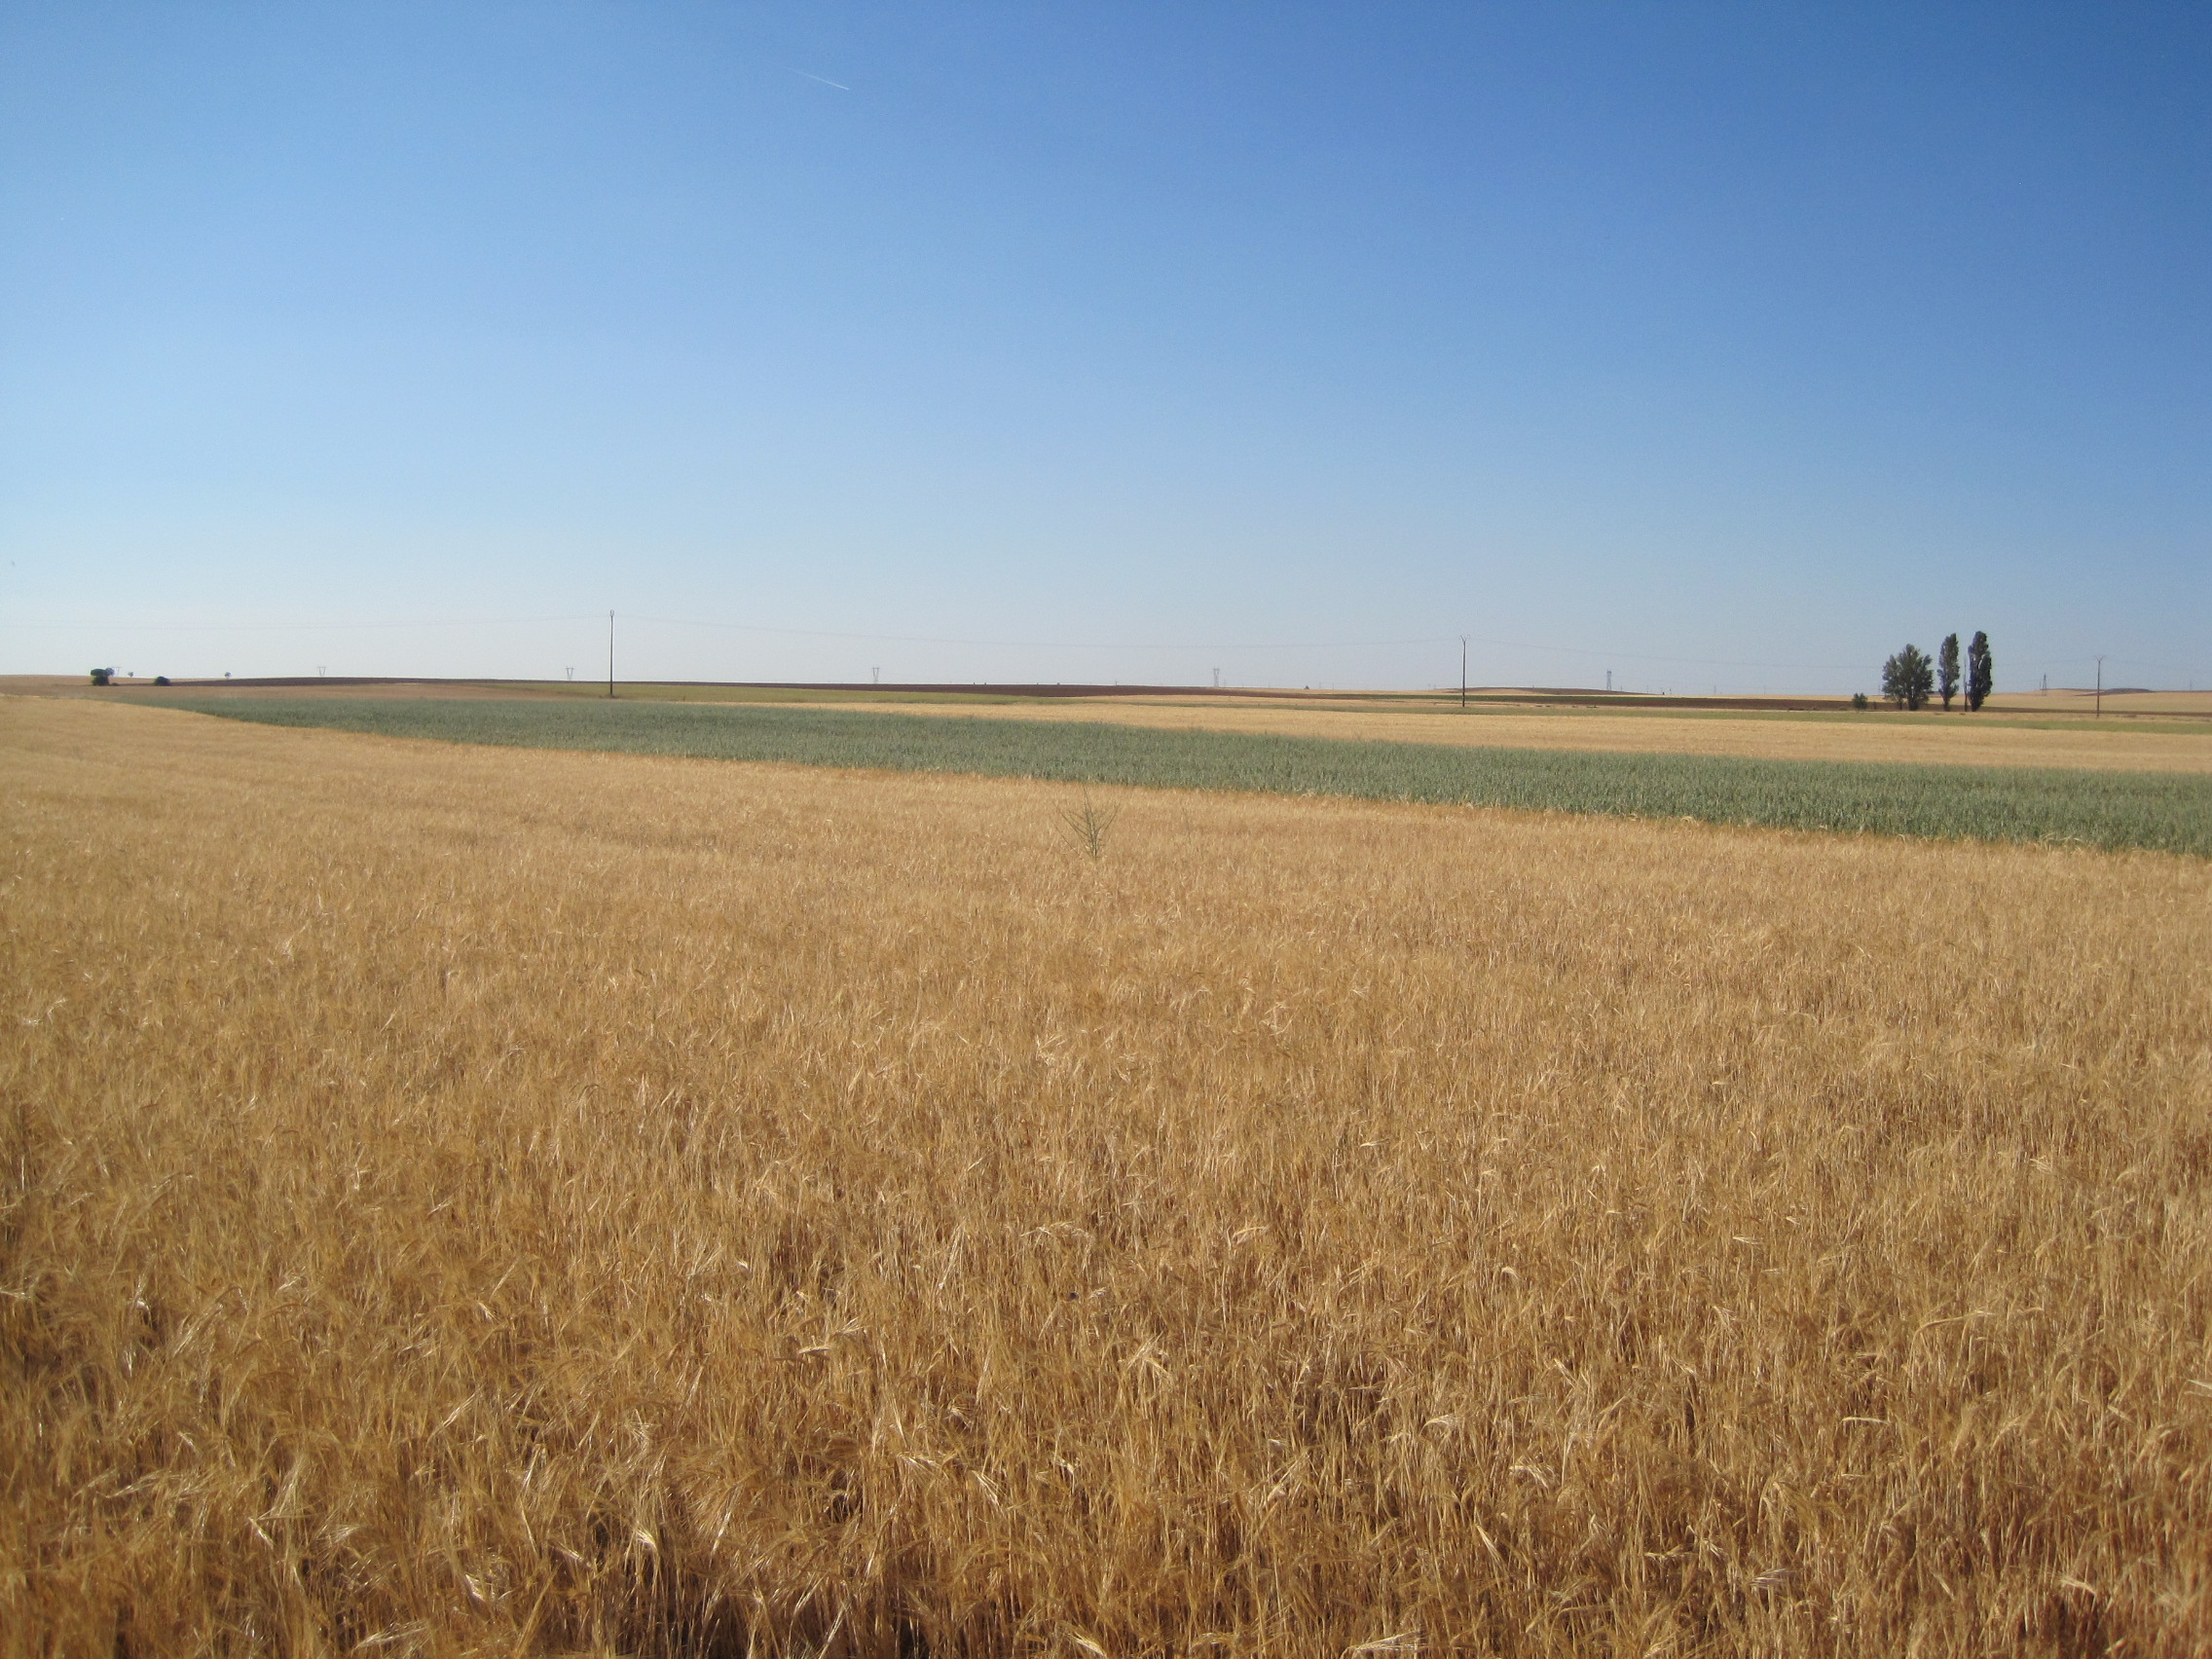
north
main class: Cropland
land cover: Barley
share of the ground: > 75 %
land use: Agriculture (excluding fallow land and kitchen gardens)
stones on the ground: 10 - 25 %
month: June
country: ES
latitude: 41.8203
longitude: -5.1395
